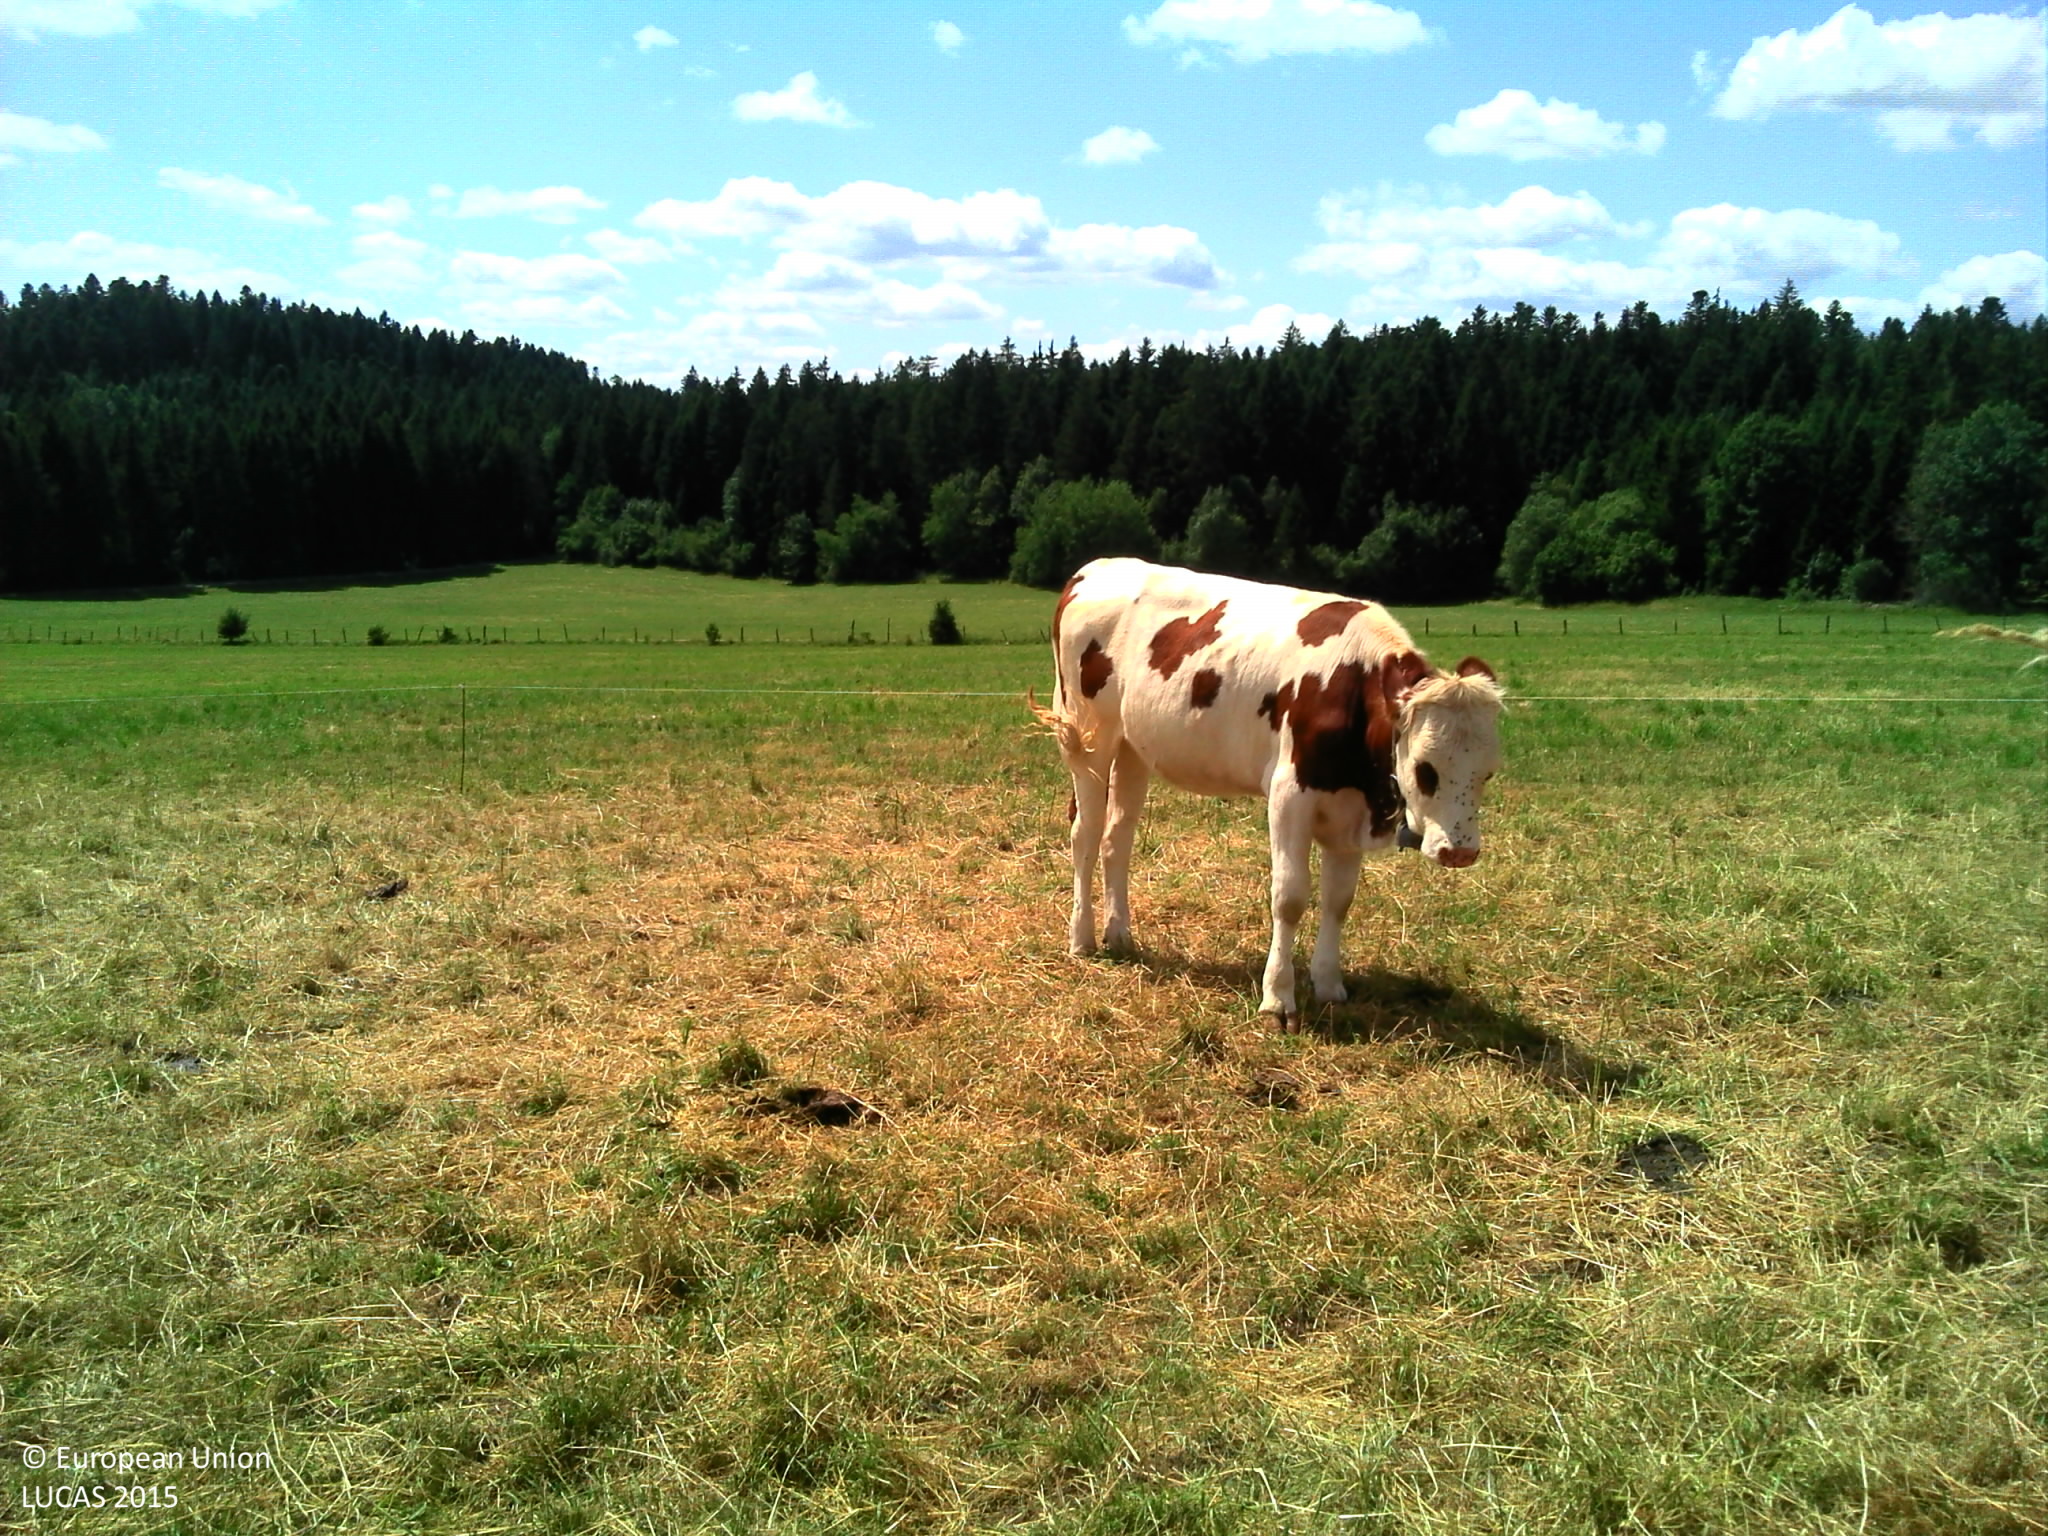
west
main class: Grassland
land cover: Grassland without tree/shrub cover
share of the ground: > 75 %
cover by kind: herbaceous plants 100 %
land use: Agriculture (excluding fallow land and kitchen gardens)
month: July
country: FR
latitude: 46.8374
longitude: 6.0558
